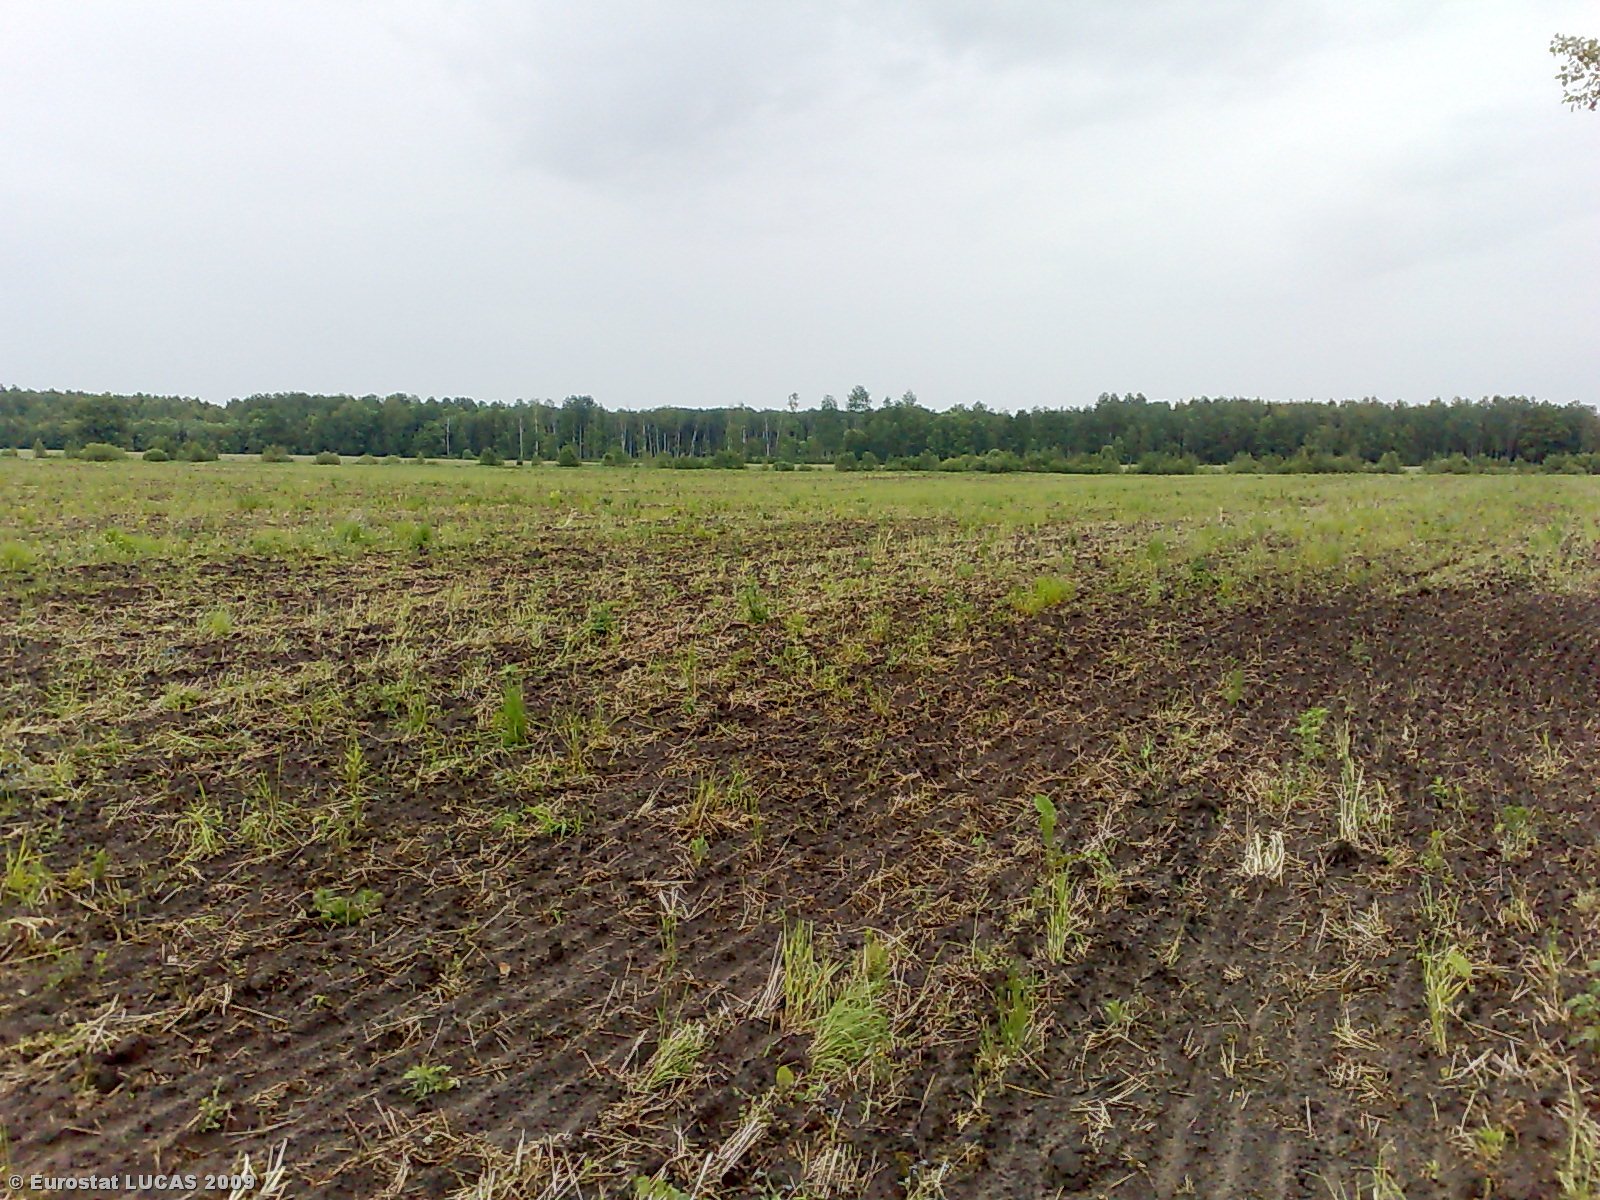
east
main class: Grassland
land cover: Spontaneously vegetated surfaces
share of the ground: 10 - 25 %
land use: Fallow land
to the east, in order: Spontaneously vegetated surfaces
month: June
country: LT
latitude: 55.9239
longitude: 24.0270
